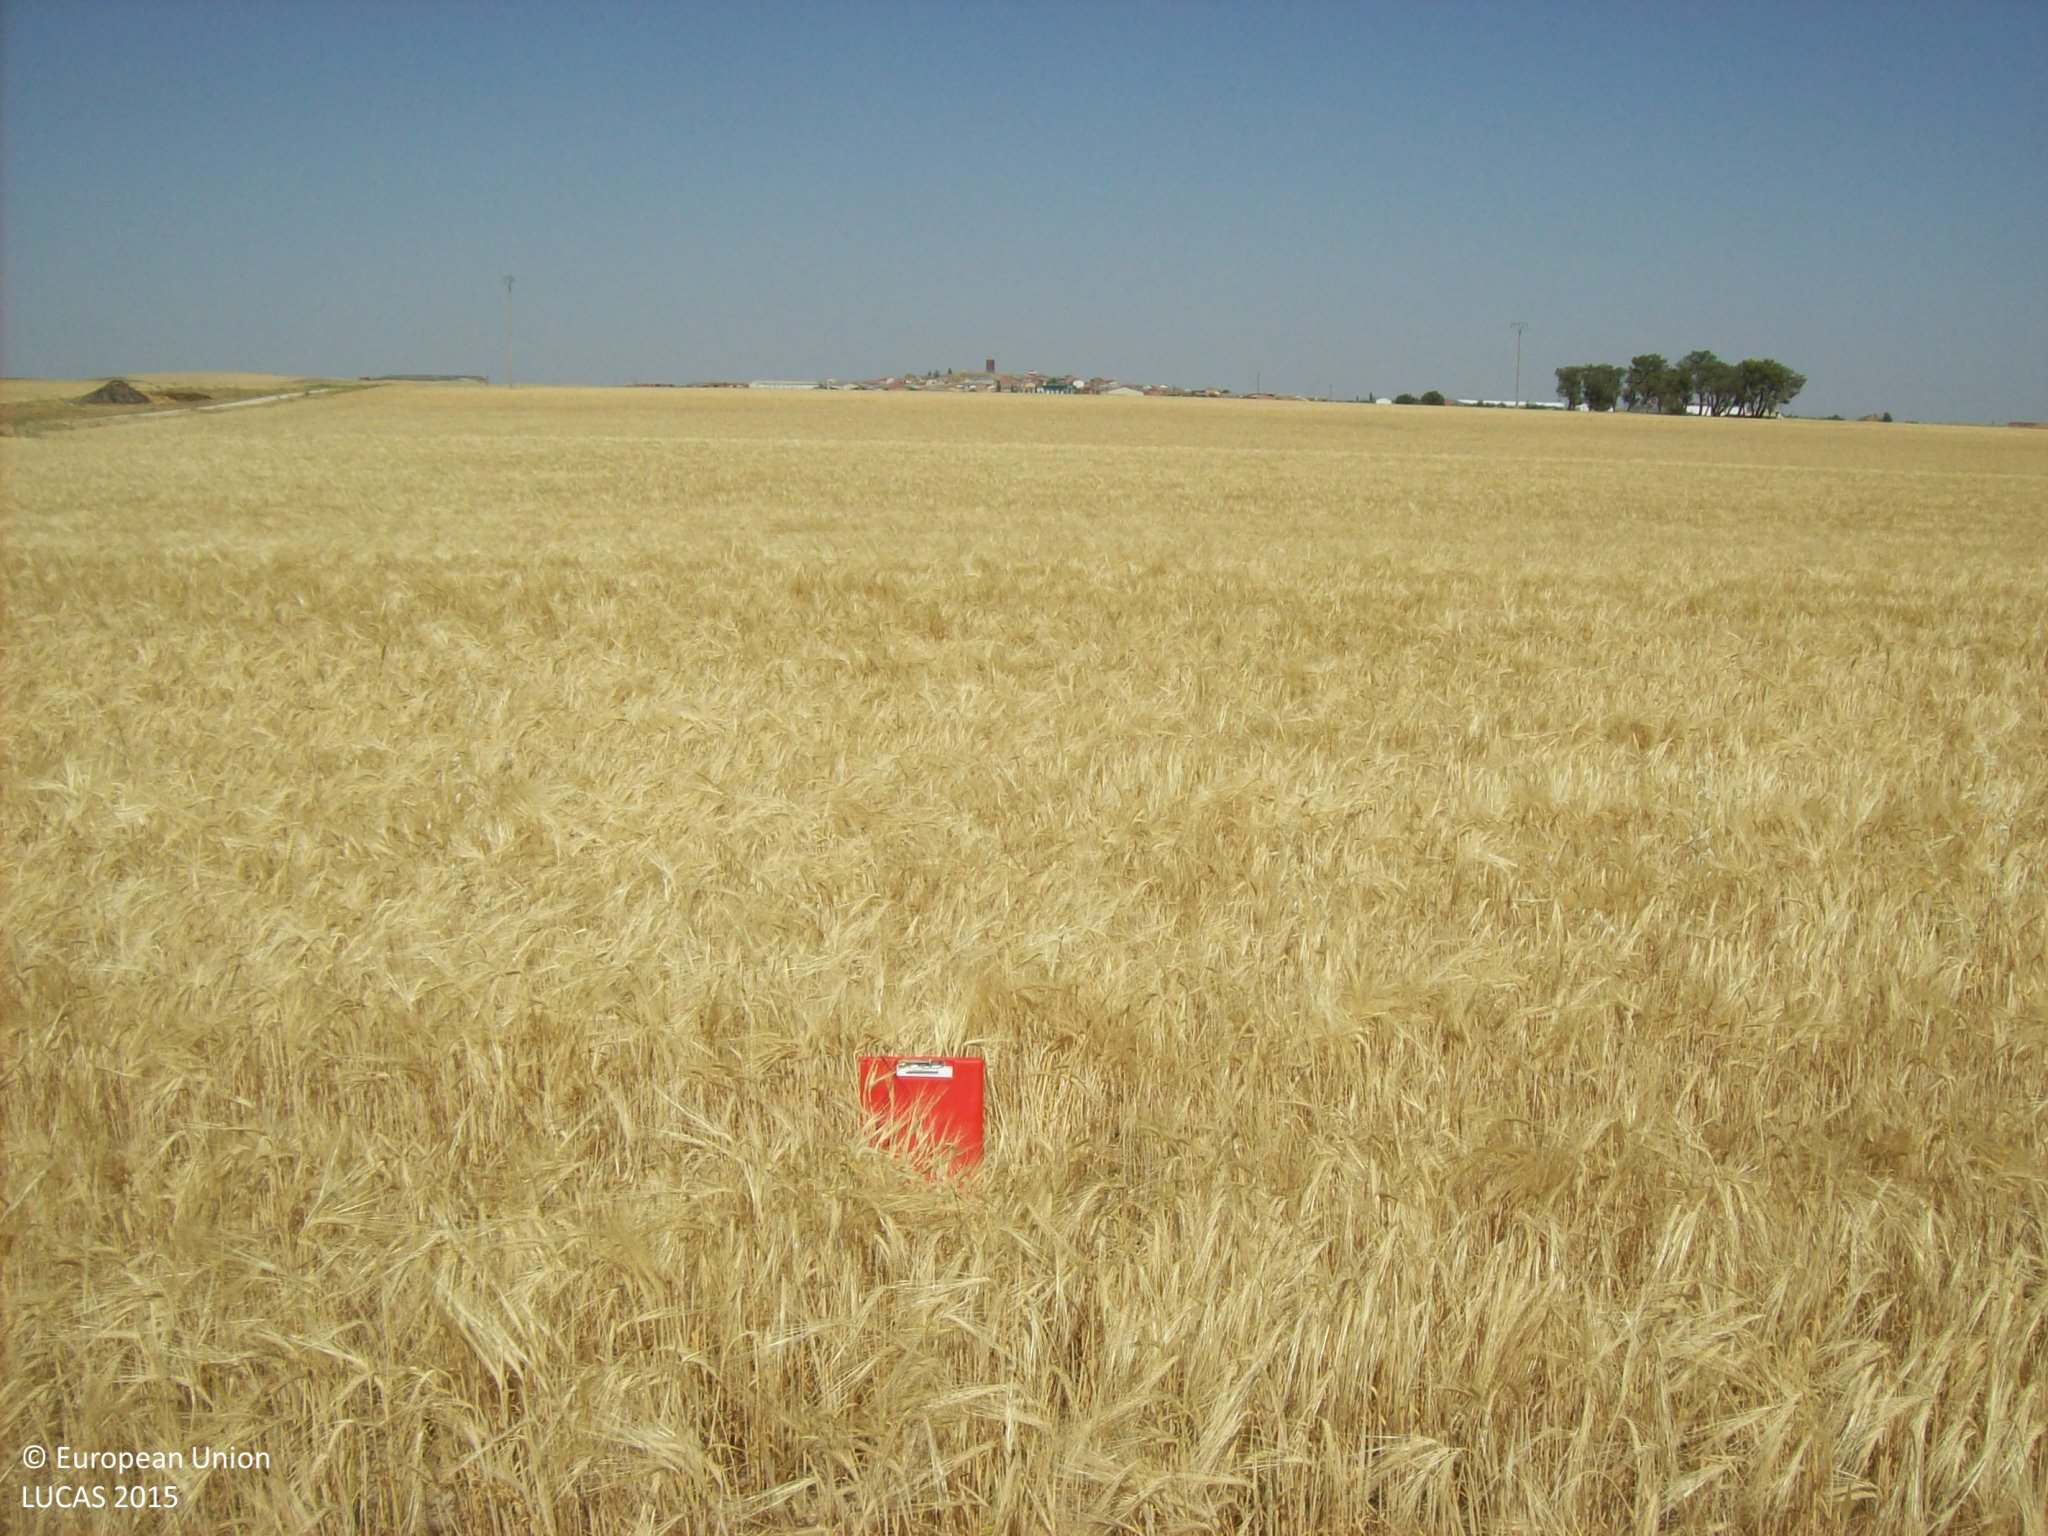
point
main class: Cropland
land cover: Barley
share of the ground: > 75 %
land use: Agriculture (excluding fallow land and kitchen gardens)
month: June
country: ES
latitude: 41.2050
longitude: -5.0839
